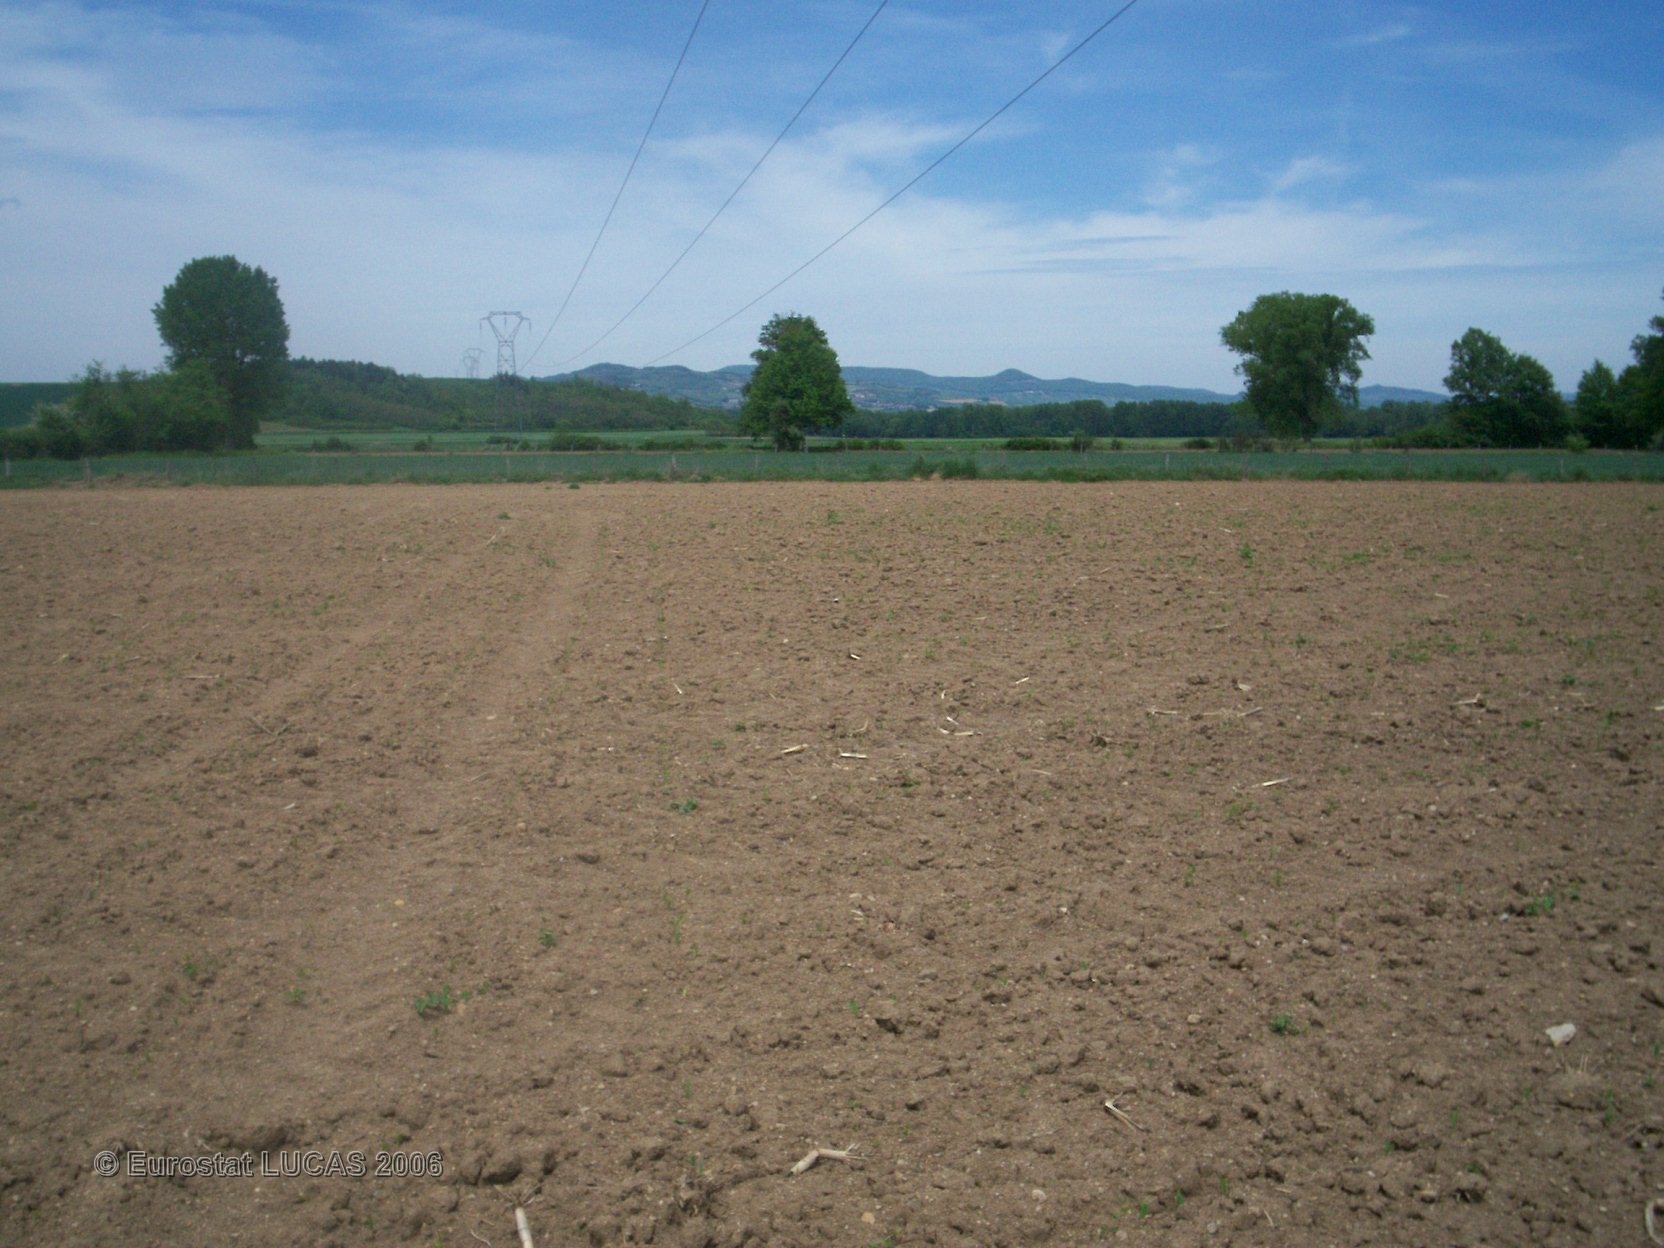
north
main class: Cropland
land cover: Maize
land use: Agriculture (excluding fallow land and kitchen gardens)
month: May
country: FR
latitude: 45.5089
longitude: 3.3070
